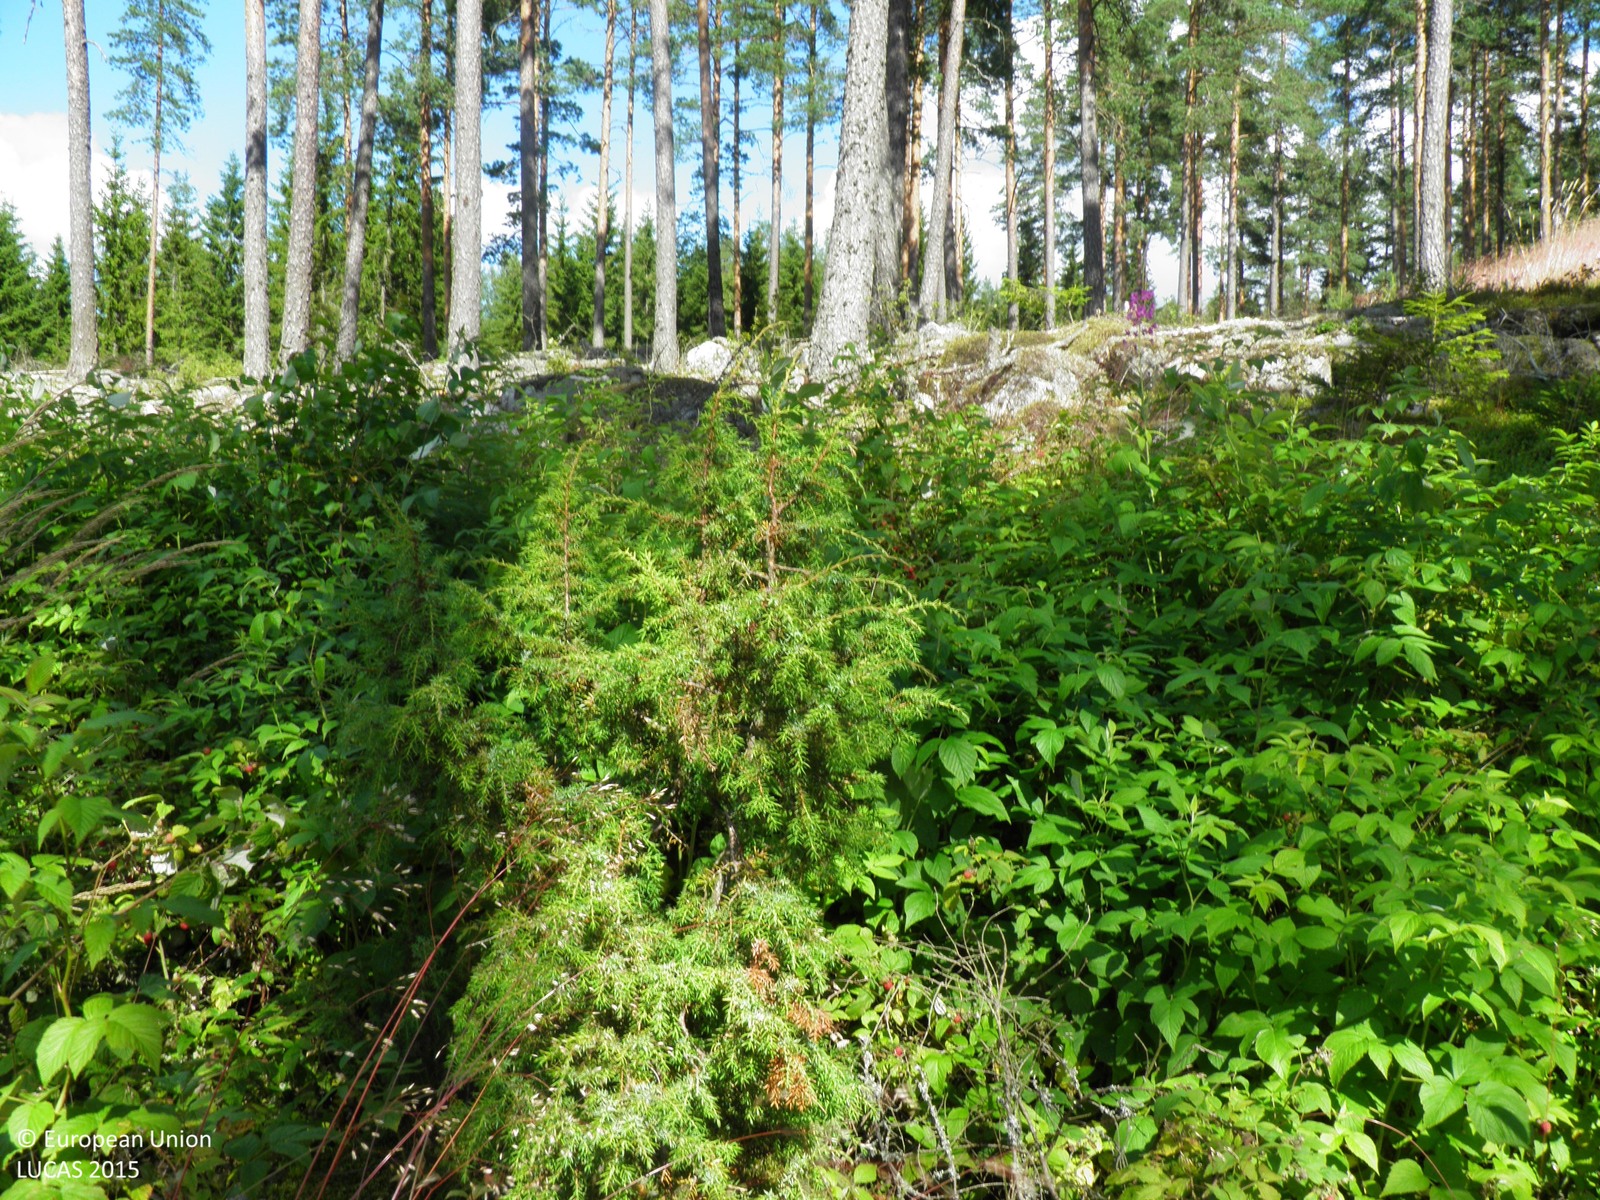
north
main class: Woodland
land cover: Pine dominated coniferous woodland
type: hemiboreal forest and nemoral coniferous forest and mixed broadleaved-coniferous forest
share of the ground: 25 - 50 %
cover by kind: shrubs 30 %, coniferous forest trees 25 %, lichens and mosses 25 %, herbaceous plants 20 %
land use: Forestry
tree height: > 5 m
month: August
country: FI
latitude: 60.9426
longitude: 23.0516
